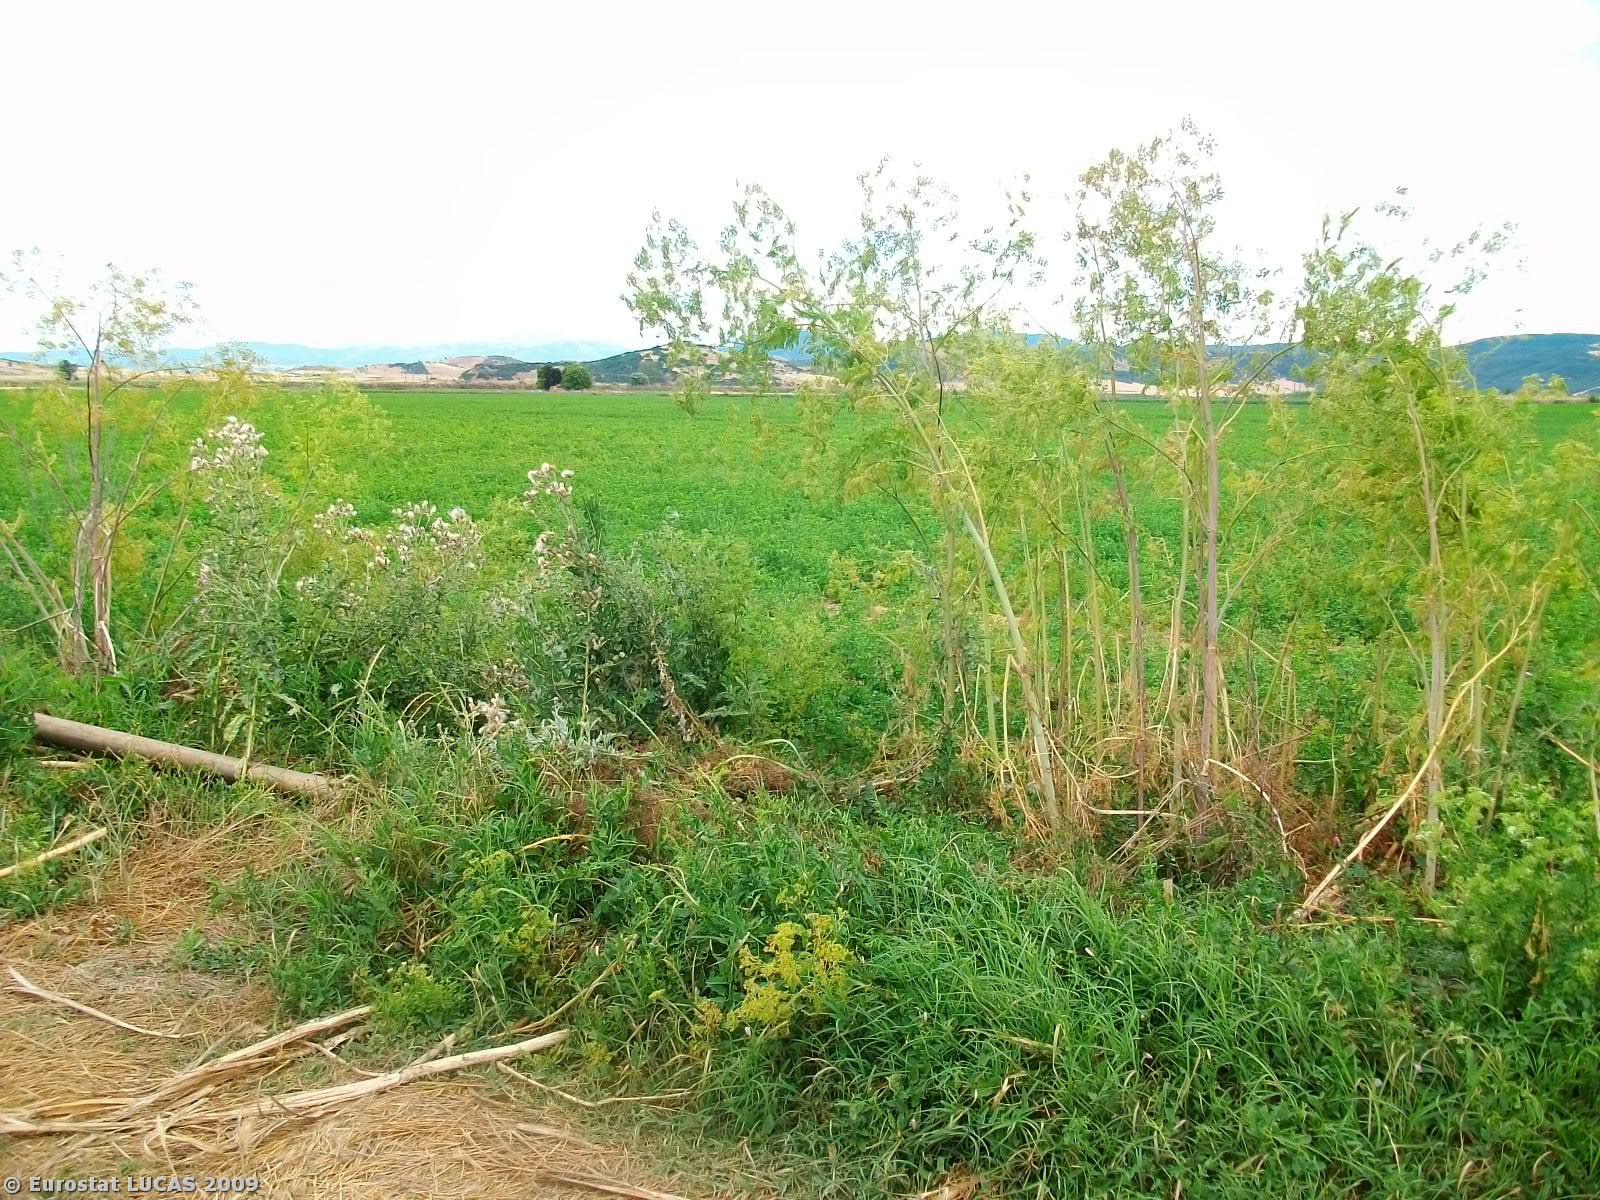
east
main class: Cropland
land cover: Other fibre and oleaginous crops
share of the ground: > 75 %
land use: Agriculture (excluding fallow land and kitchen gardens)
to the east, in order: Other fibre and oleaginous crops; Oats; Tracks; Grass margins; Shruby margins; Other fibre and oleaginous crops
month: June
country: GR
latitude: 39.0408
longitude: 22.2389
